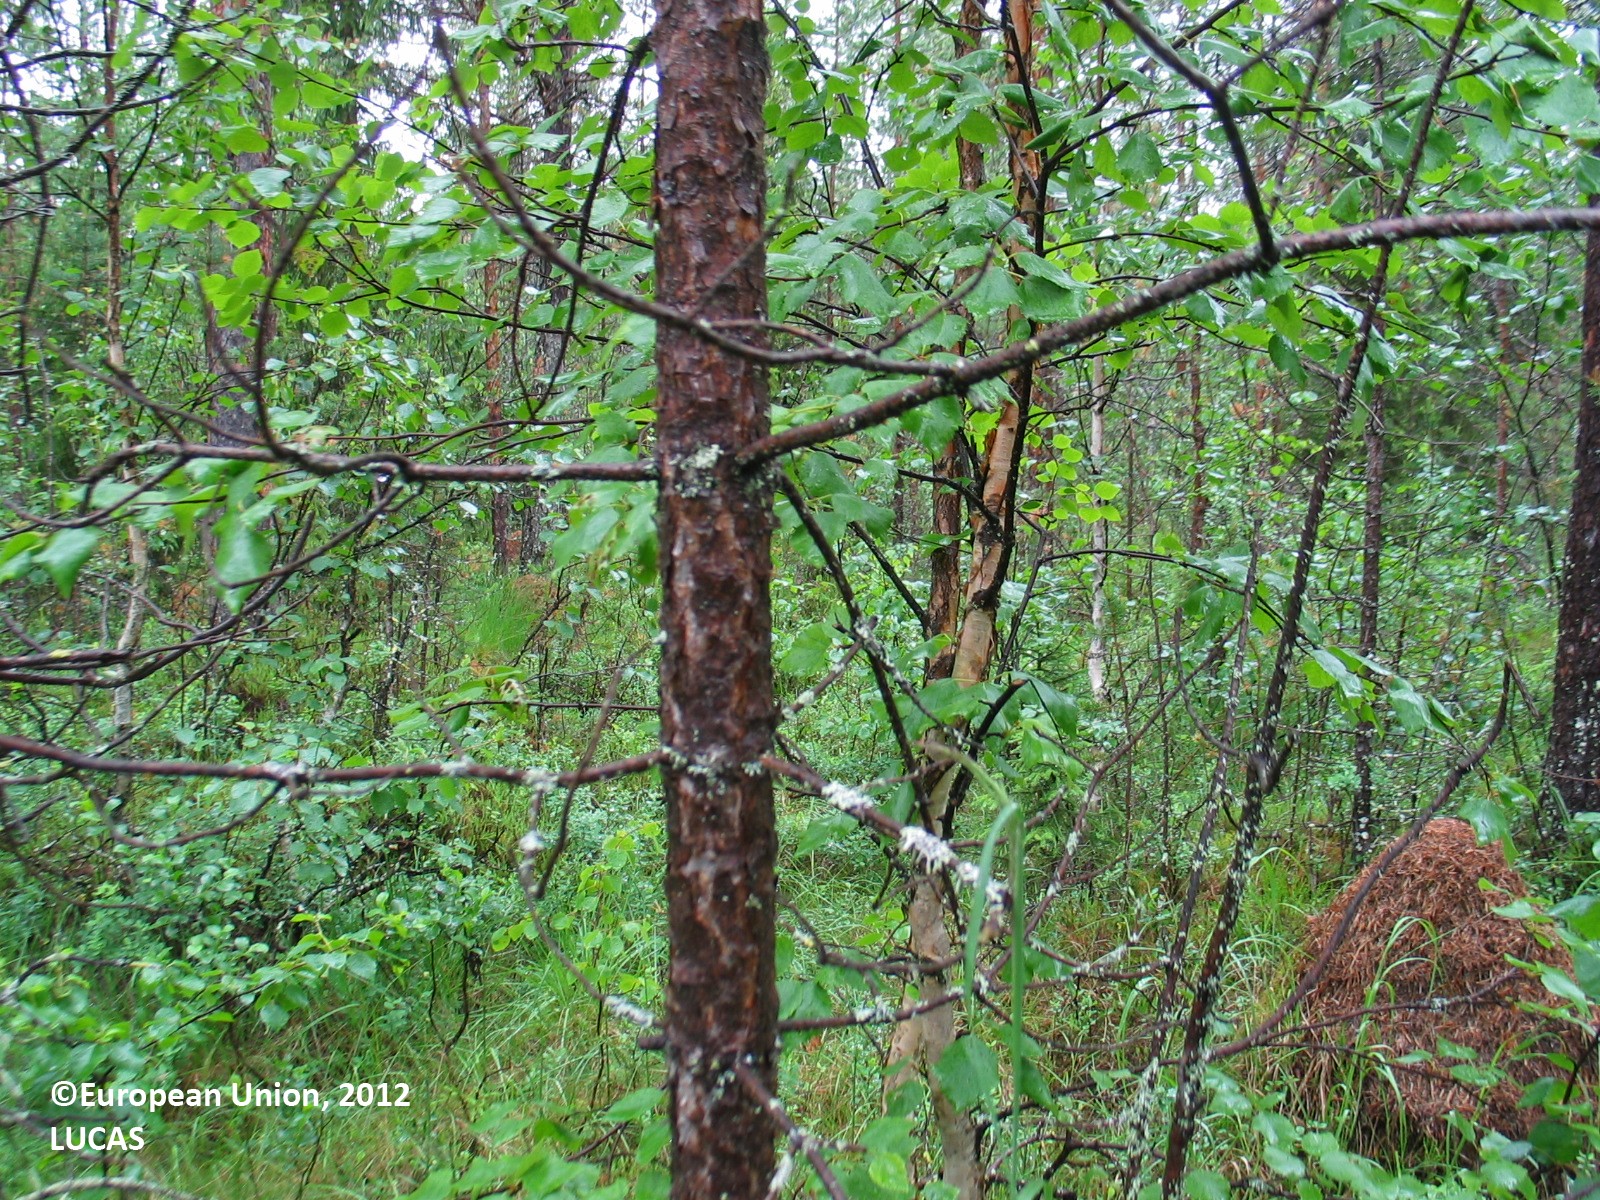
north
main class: Woodland
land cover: Pine dominated coniferous woodland
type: mire and swamp forests
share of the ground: 50 - 75 %
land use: Forestry
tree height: > 5 m
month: July
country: FI
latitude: 66.0735
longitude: 24.8843
